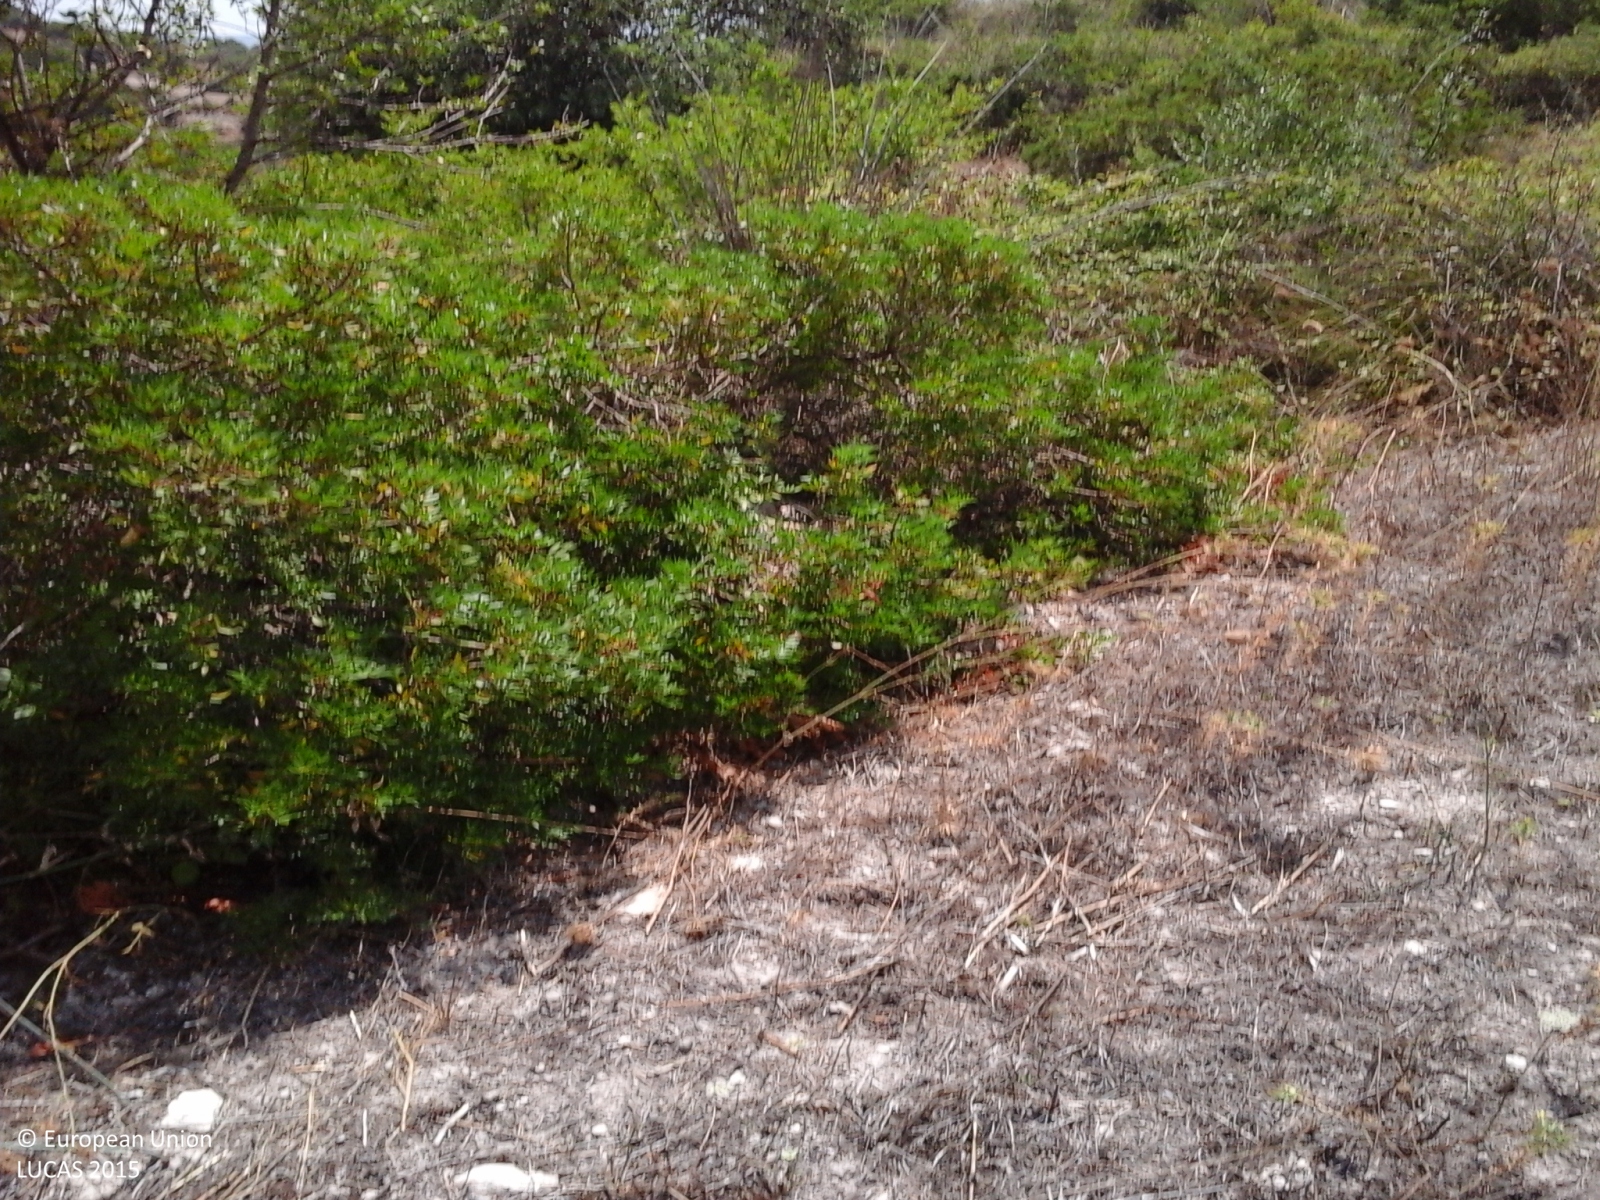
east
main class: Shrubland
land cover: Shrubland with sparse tree cover
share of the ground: > 75 %
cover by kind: herbaceous plants 55 %, shrubs 40 %, coniferous forest trees 5 %
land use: Agriculture (excluding fallow land and kitchen gardens)
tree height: < 5 m
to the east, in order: Shrubland with sparse tree cover; Shrubland without tree cover; Shrubland with sparse tree cover; Ditches and canals; Shrubland with sparse tree cover; Ditches and canals; Shrubland with sparse tree cover; Arable land (only in case pi); Abandoned hedges; Dry stone walls; Arable land (only in case pi); Abandoned hedges; Dry stone walls; Arable land (only in case pi); Abandoned hedges; Dry stone walls; Arable land (only in case pi); Abandoned hedges; Dry stone walls; Abandoned hedges; Arable land (only in case pi); Abandoned hedges; Dry stone walls; Arable land (only in case pi); Dry stone walls; Arable land (only in case pi)
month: August
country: IT
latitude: 36.9498
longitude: 14.8691
